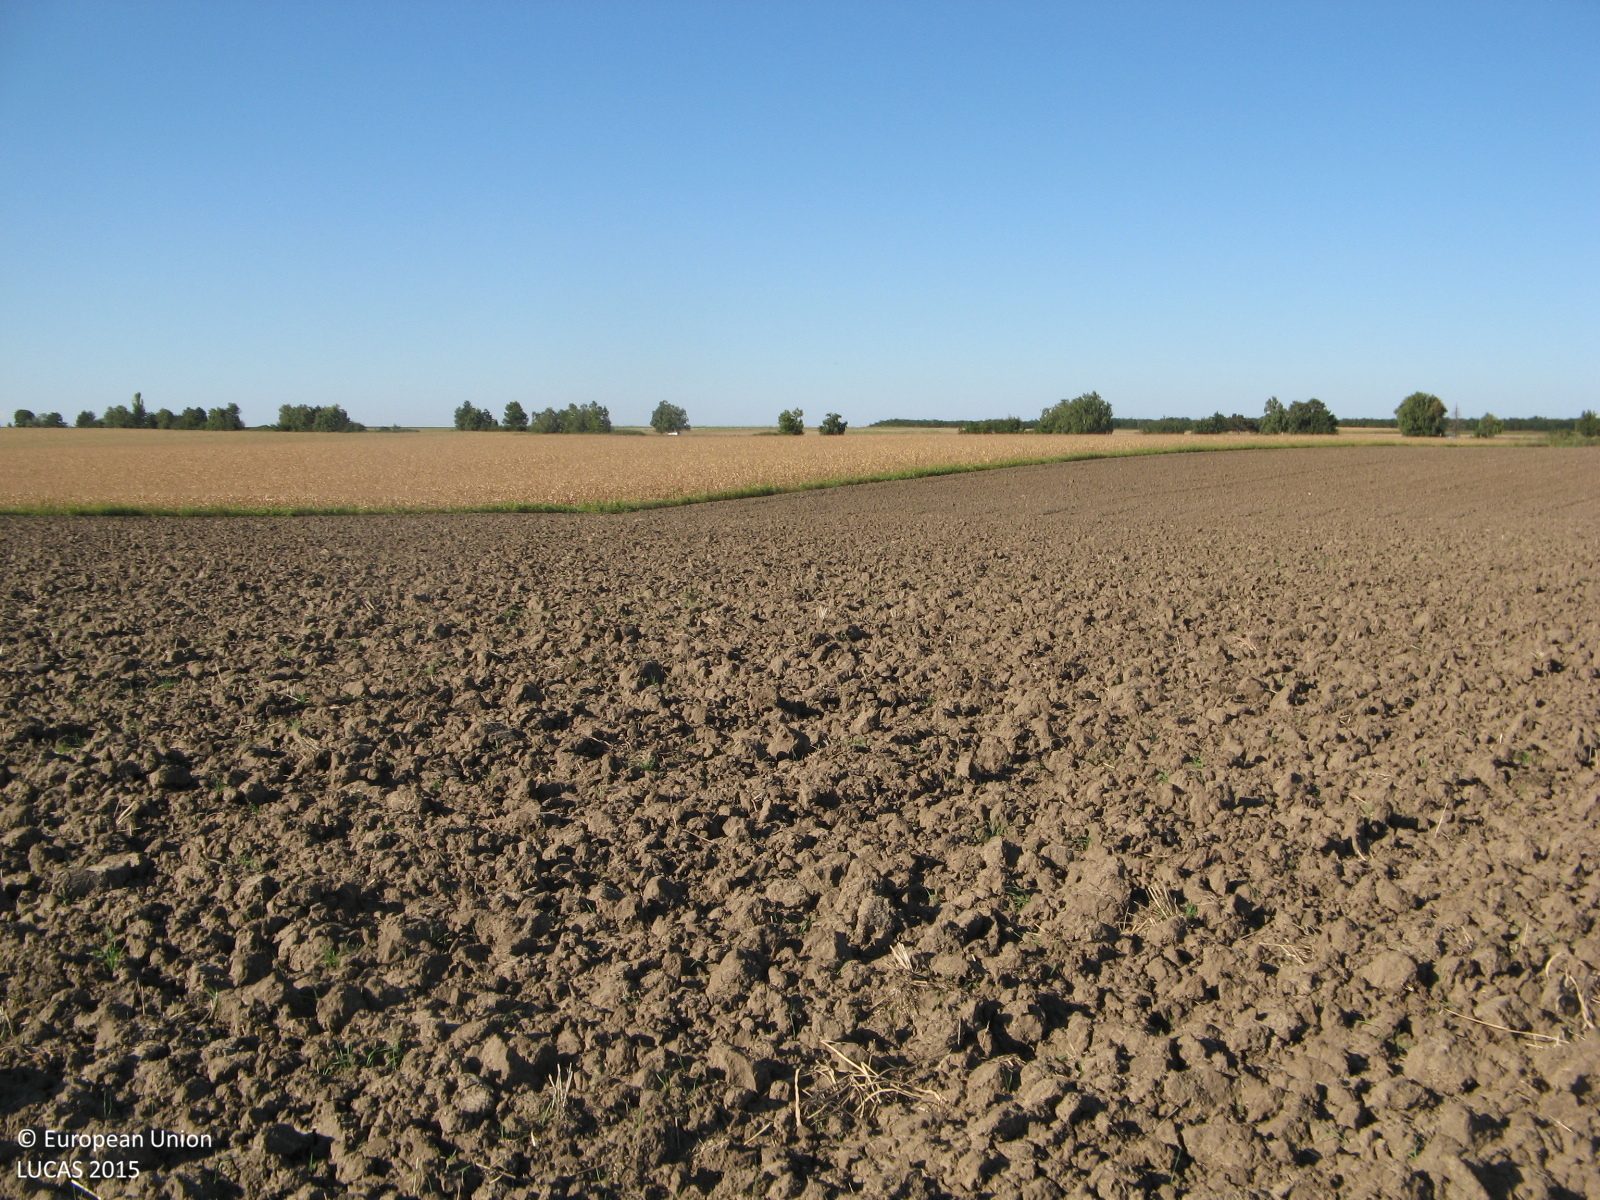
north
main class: Cropland
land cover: Common wheat
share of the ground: < 10 %
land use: Agriculture (excluding fallow land and kitchen gardens)
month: September
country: BG
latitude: 43.7049
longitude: 26.1184
